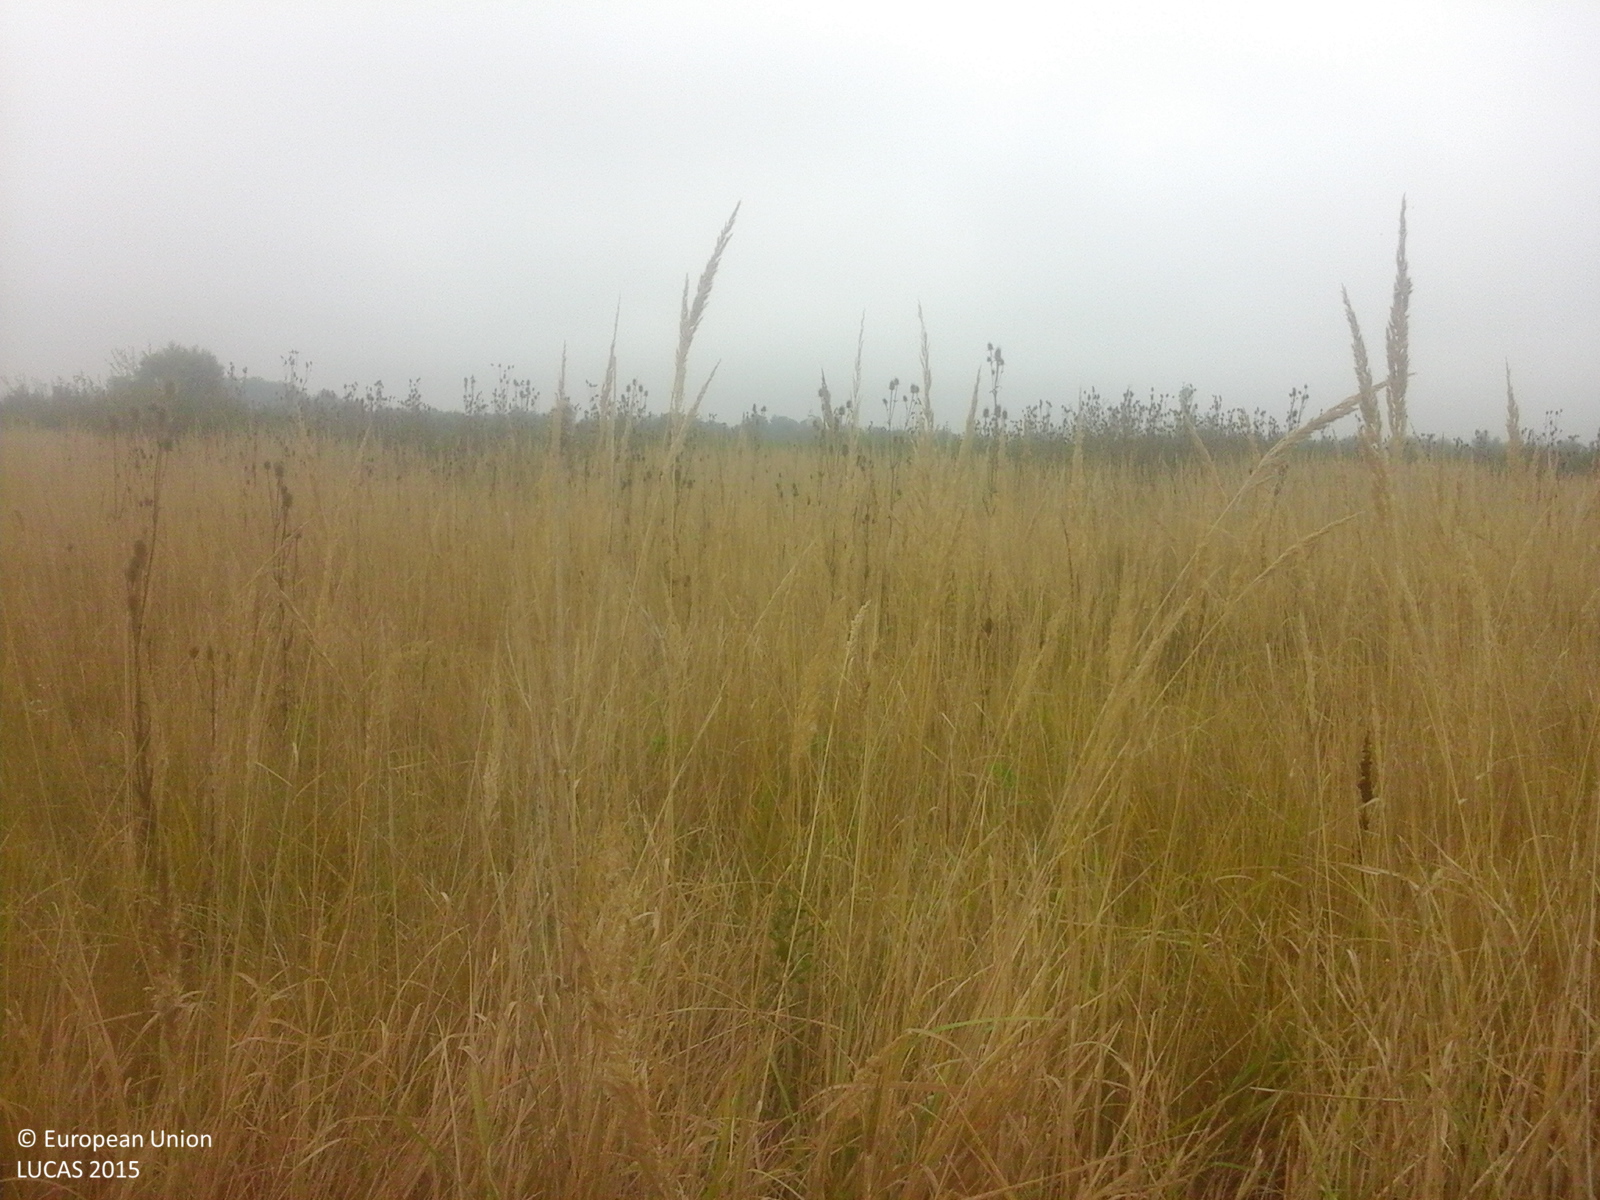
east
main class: Grassland
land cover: Spontaneously vegetated surfaces
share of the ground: > 75 %
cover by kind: herbaceous plants 100 %
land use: Fallow land
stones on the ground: < 10 %
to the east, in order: Spontaneously vegetated surfaces; Other fresh vegetables; Spontaneously vegetated surfaces; Maize; Other fresh vegetables; Spontaneously vegetated surfaces; Maize; Other bare soil; Spontaneously vegetated surfaces
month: September
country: RO
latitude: 45.8308
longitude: 22.0519
